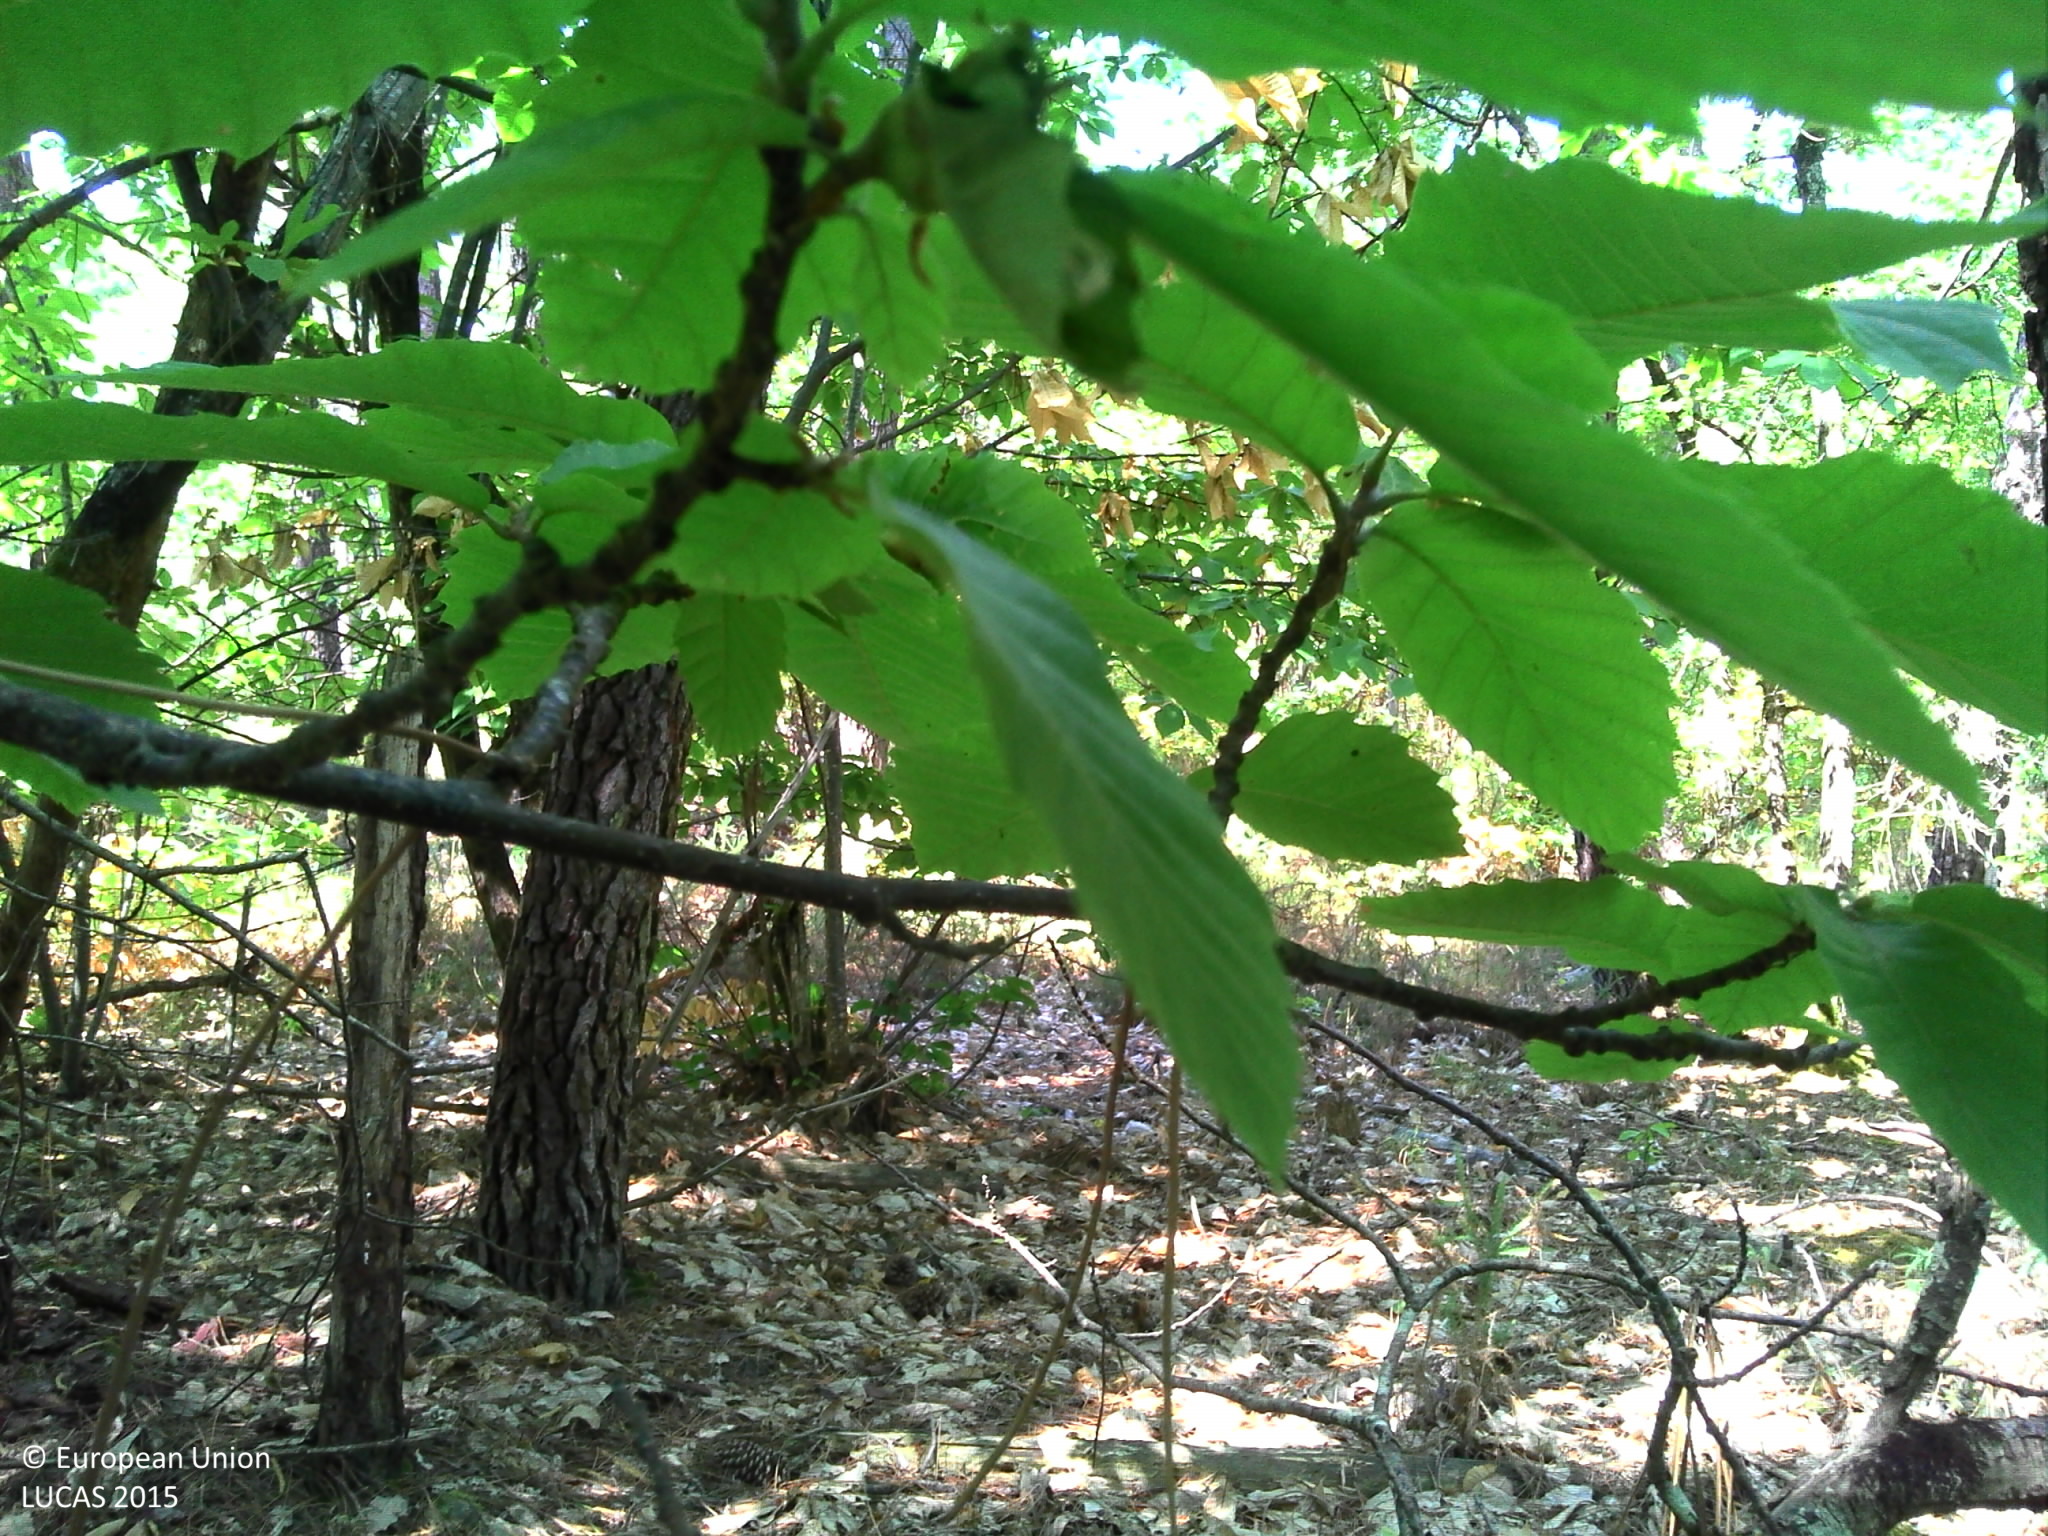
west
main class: Woodland
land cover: Broadleaved woodland
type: thermophilous deciduous forest
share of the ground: > 75 %
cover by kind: broadleaved forest trees 40 %, unconsolidated bare surface 20 %, coniferous forest trees 10 %, shrubs 10 %, herbaceous plants 10 %, lichens and mosses 10 %
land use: Forestry
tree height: > 5 m
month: July
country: FR
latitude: 45.0729
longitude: 0.4752
